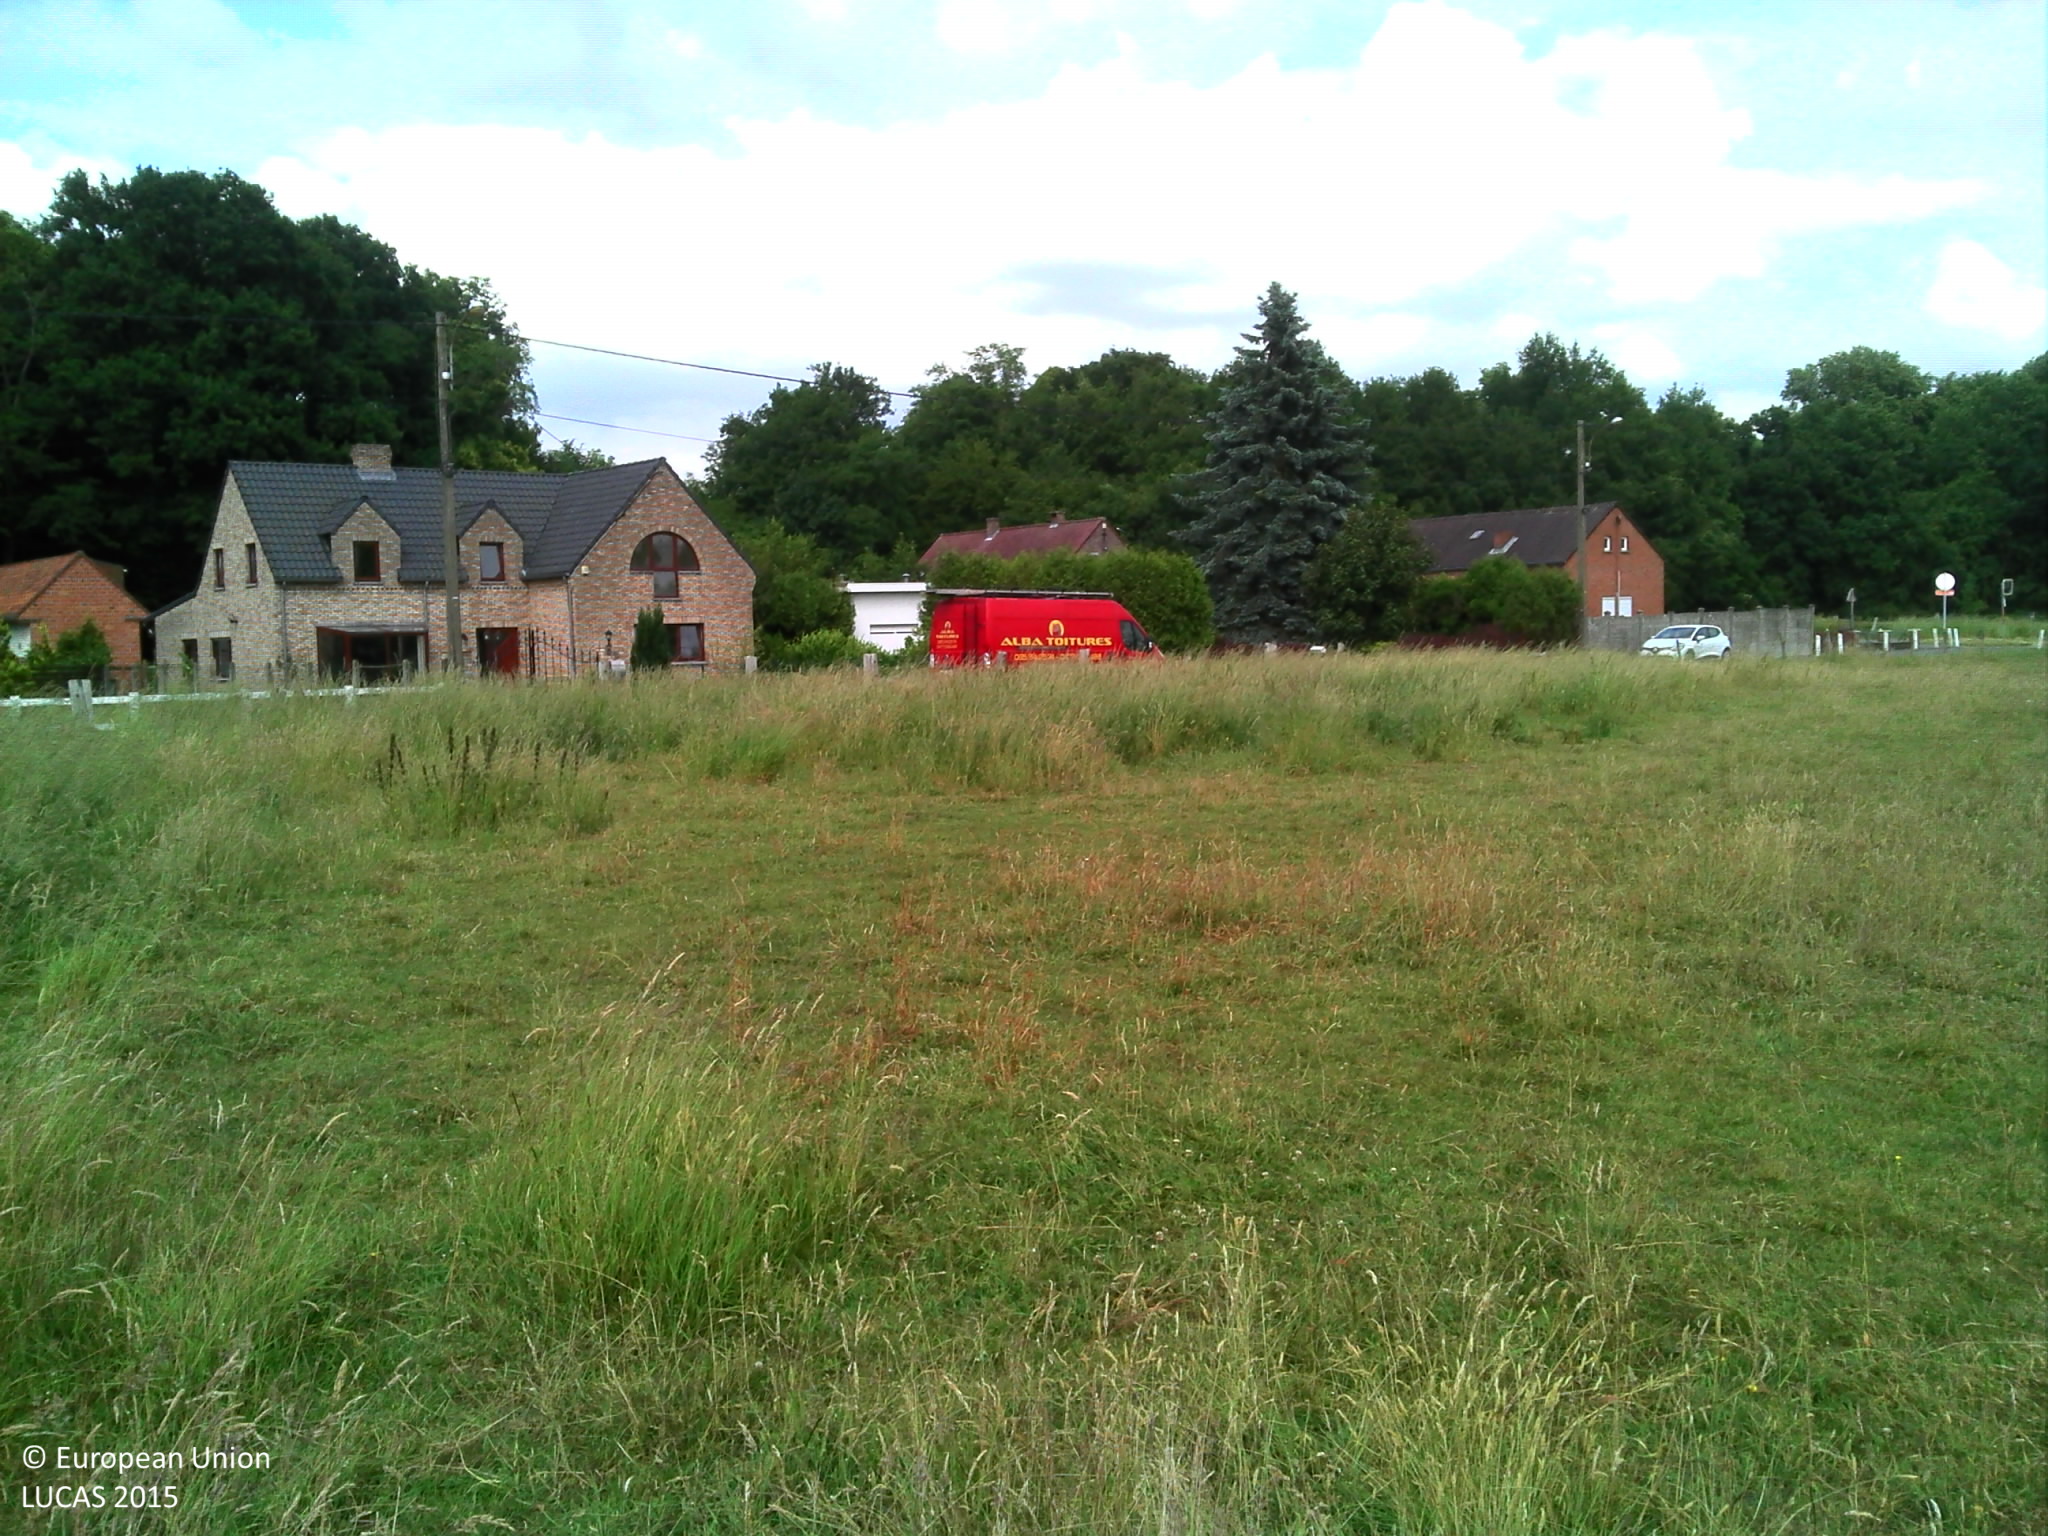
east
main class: Grassland
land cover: Grassland without tree/shrub cover
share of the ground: > 75 %
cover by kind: herbaceous plants 100 %
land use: Agriculture (excluding fallow land and kitchen gardens)
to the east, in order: Grassland without tree/shrub cover; Fences; Grass margins; Paved roads, cycling and walking lanes; Grass margins; Electric lines; Fences; Grassland without tree/shrub cover; Fences; Broadleaved woodland
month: June
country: BE
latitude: 50.4908
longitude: 3.9187
